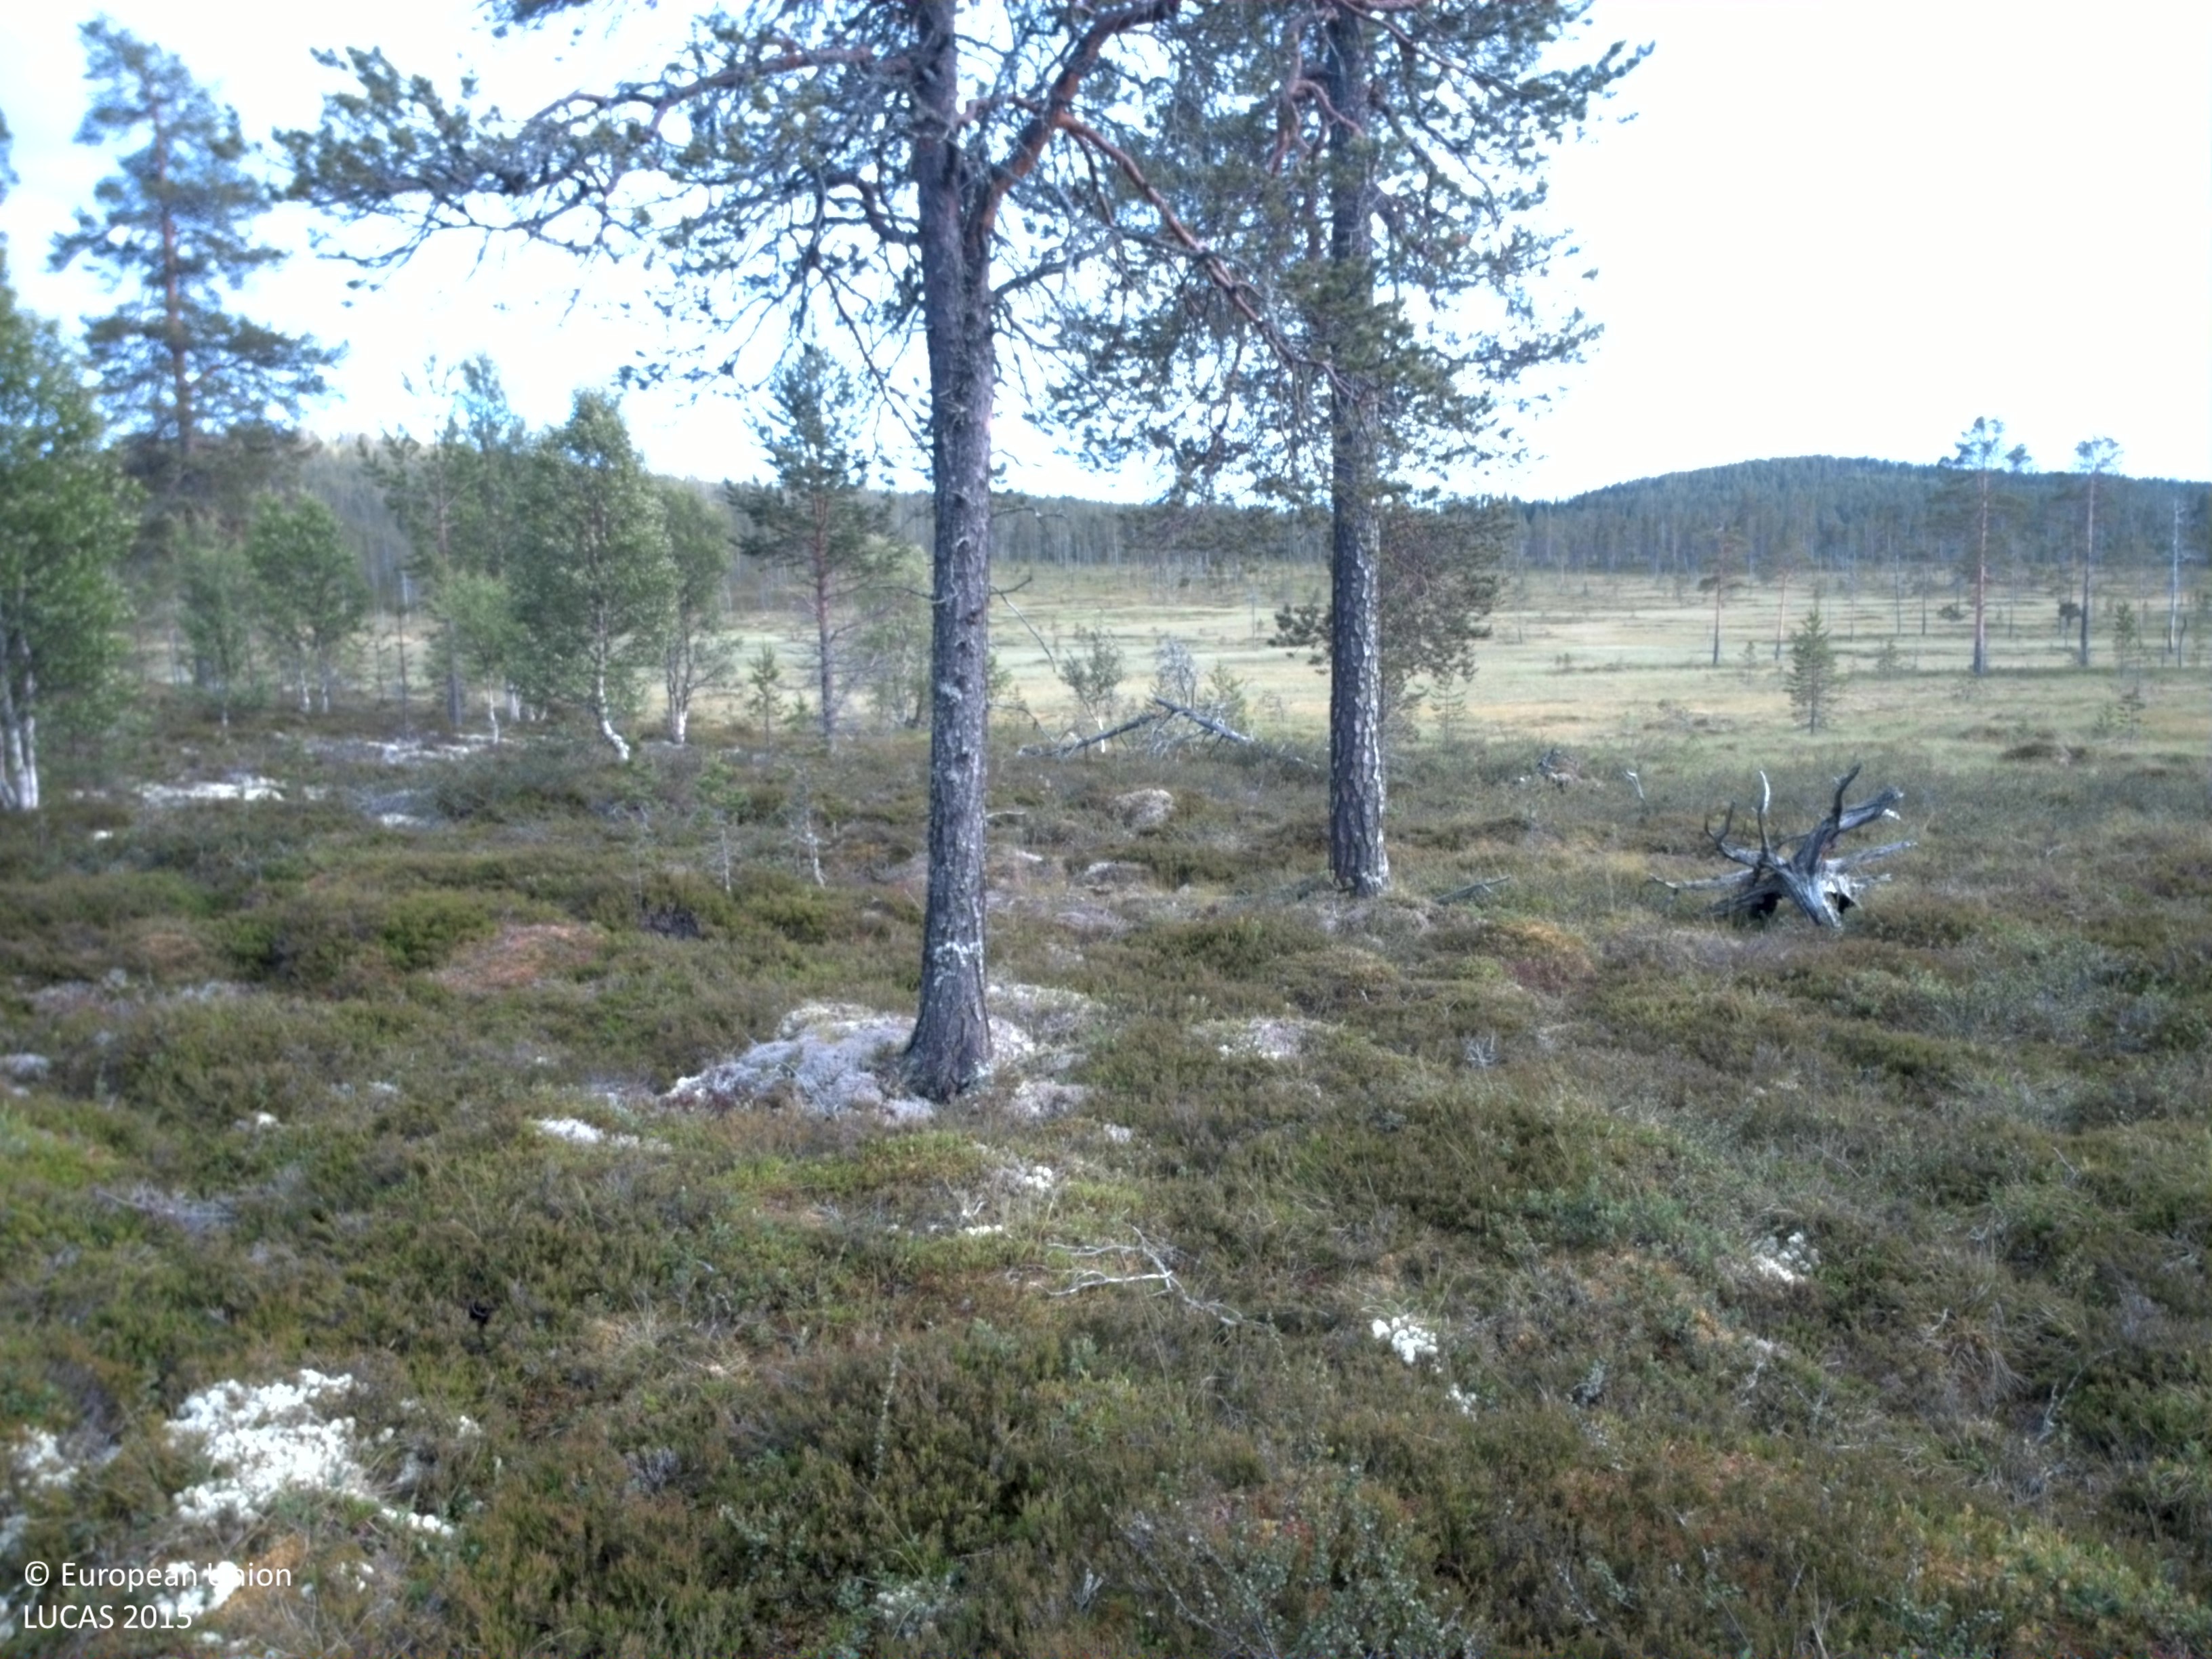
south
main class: Woodland
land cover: Pine dominated coniferous woodland
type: boreal forest
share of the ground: 10 - 25 %
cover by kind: shrubs 40 %, lichens and mosses 35 %, coniferous forest trees 15 %, herbaceous plants 10 %
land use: Forestry
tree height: < 5 m
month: July
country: SE
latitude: 61.5944
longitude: 13.6236
